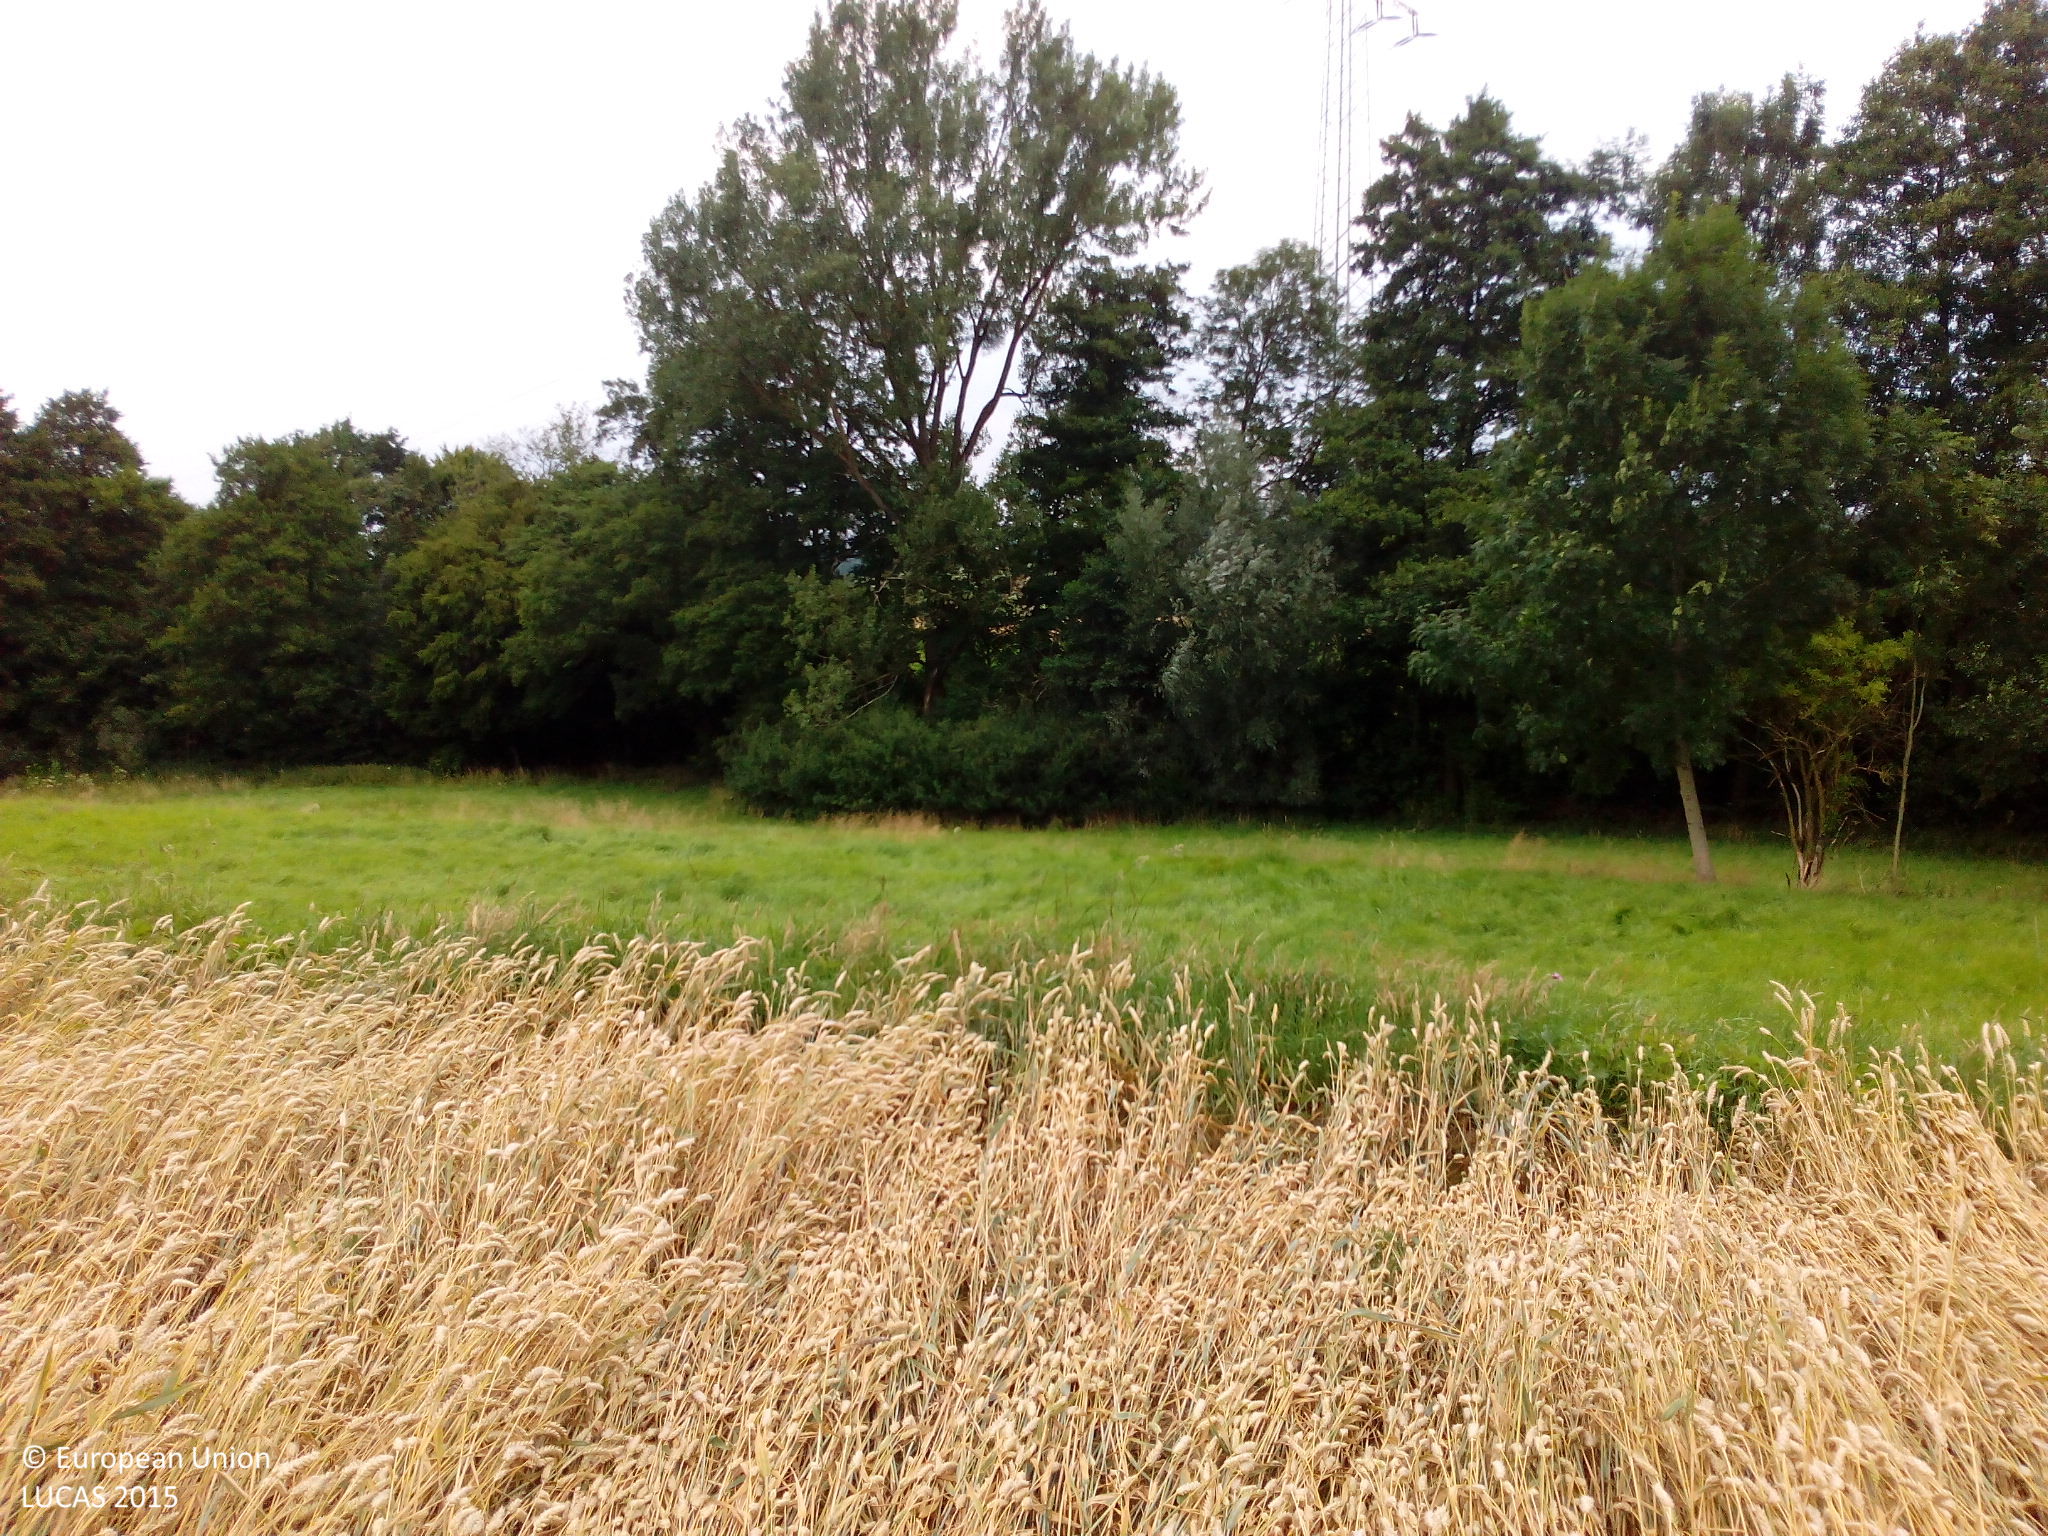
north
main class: Cropland
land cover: Triticale
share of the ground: > 75 %
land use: Agriculture (excluding fallow land and kitchen gardens)
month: August
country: DE
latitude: 51.8541
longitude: 9.2888
